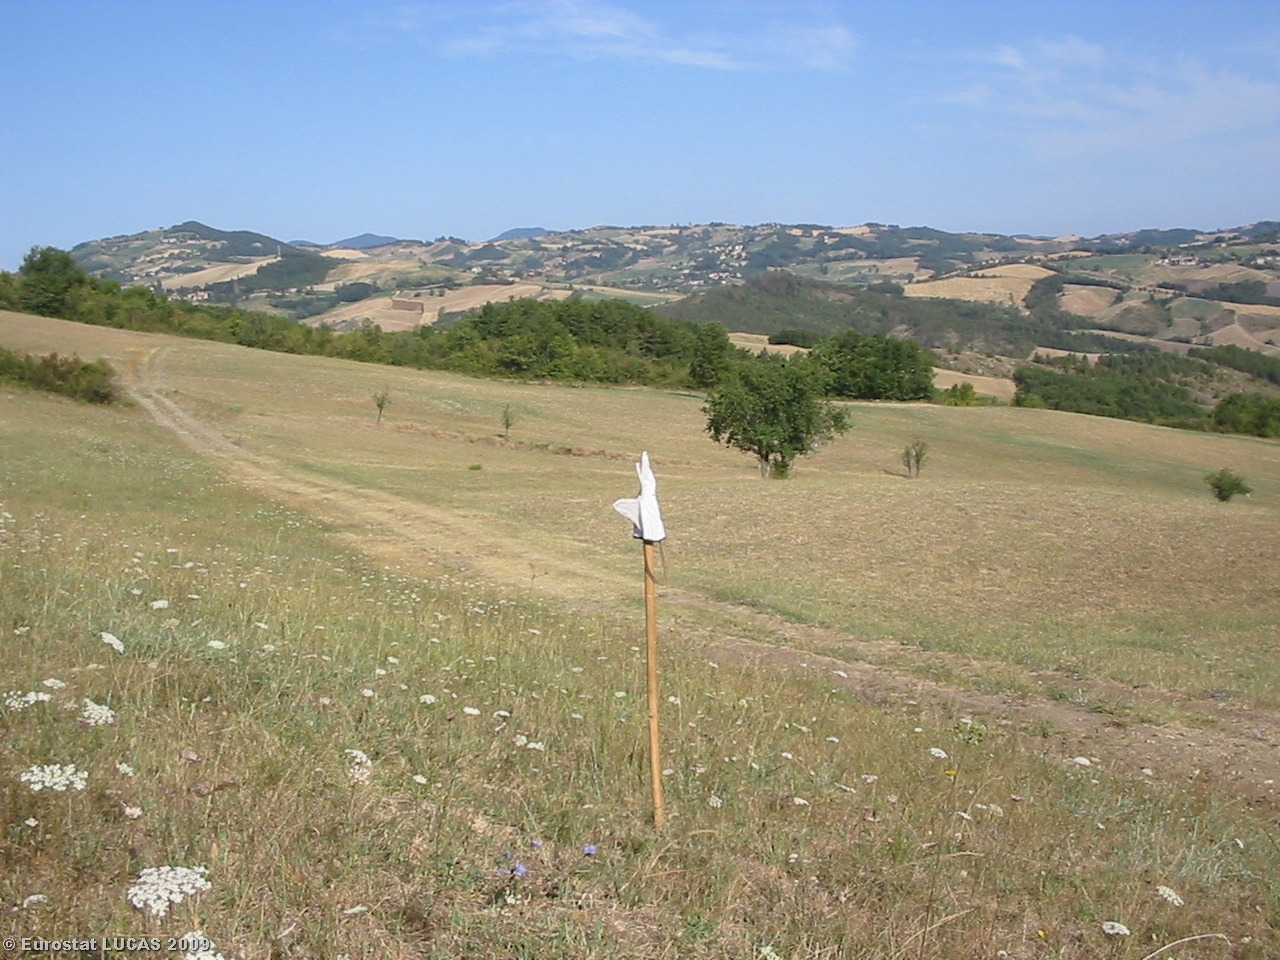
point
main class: Grassland
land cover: Grassland without tree/shrub cover
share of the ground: > 75 %
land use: Agriculture (excluding fallow land and kitchen gardens)
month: July
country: IT
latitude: 44.5484
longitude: 10.3391
